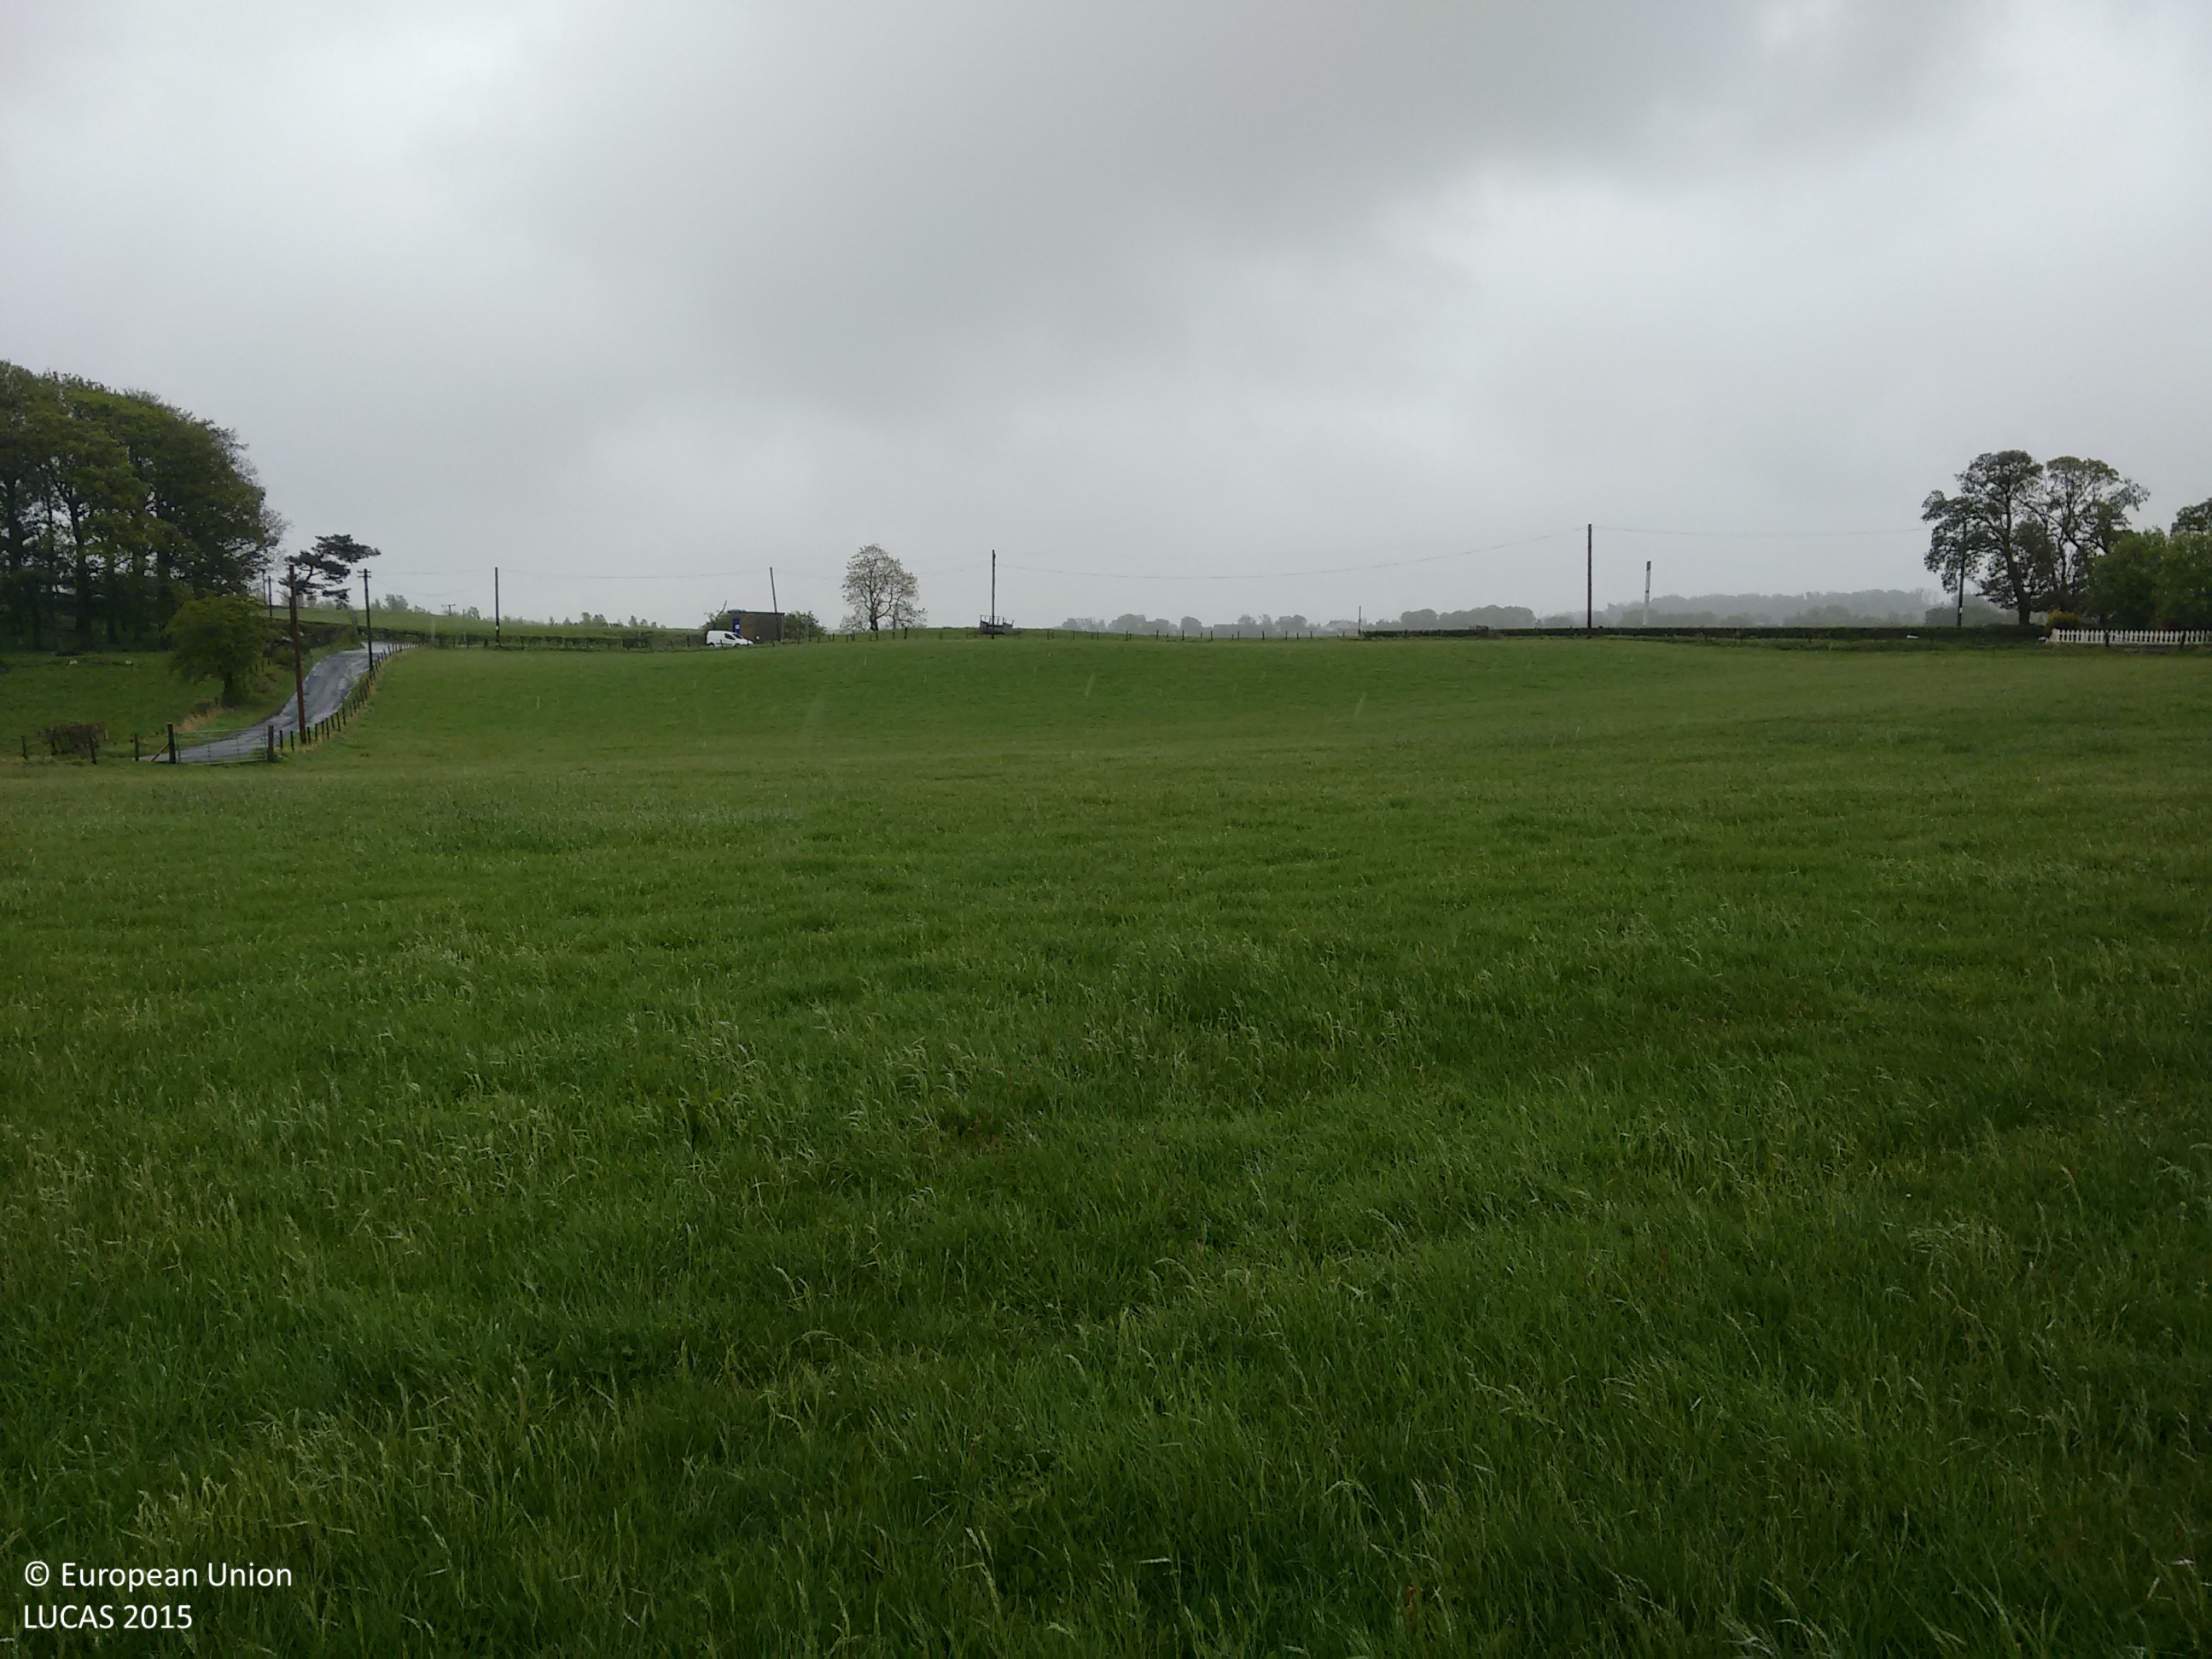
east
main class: Grassland
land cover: Grassland without tree/shrub cover
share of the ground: > 75 %
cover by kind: herbaceous plants 100 %
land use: Agriculture (excluding fallow land and kitchen gardens)
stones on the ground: < 10 %
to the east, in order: Grassland without tree/shrub cover; Fences; Electric lines; Grass margins; Paved roads, cycling and walking lanes; Grass margins; Single bushes/trees; Fences; Grassland without tree/shrub cover; Broadleaved woodland; Fences; Grass margins; Paved roads, cycling and walking lanes; Grass margins; Fences; Electric lines; Managed hedges; Grassland without tree/shrub cover
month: May
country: GB
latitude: 55.7761
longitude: -4.3646
